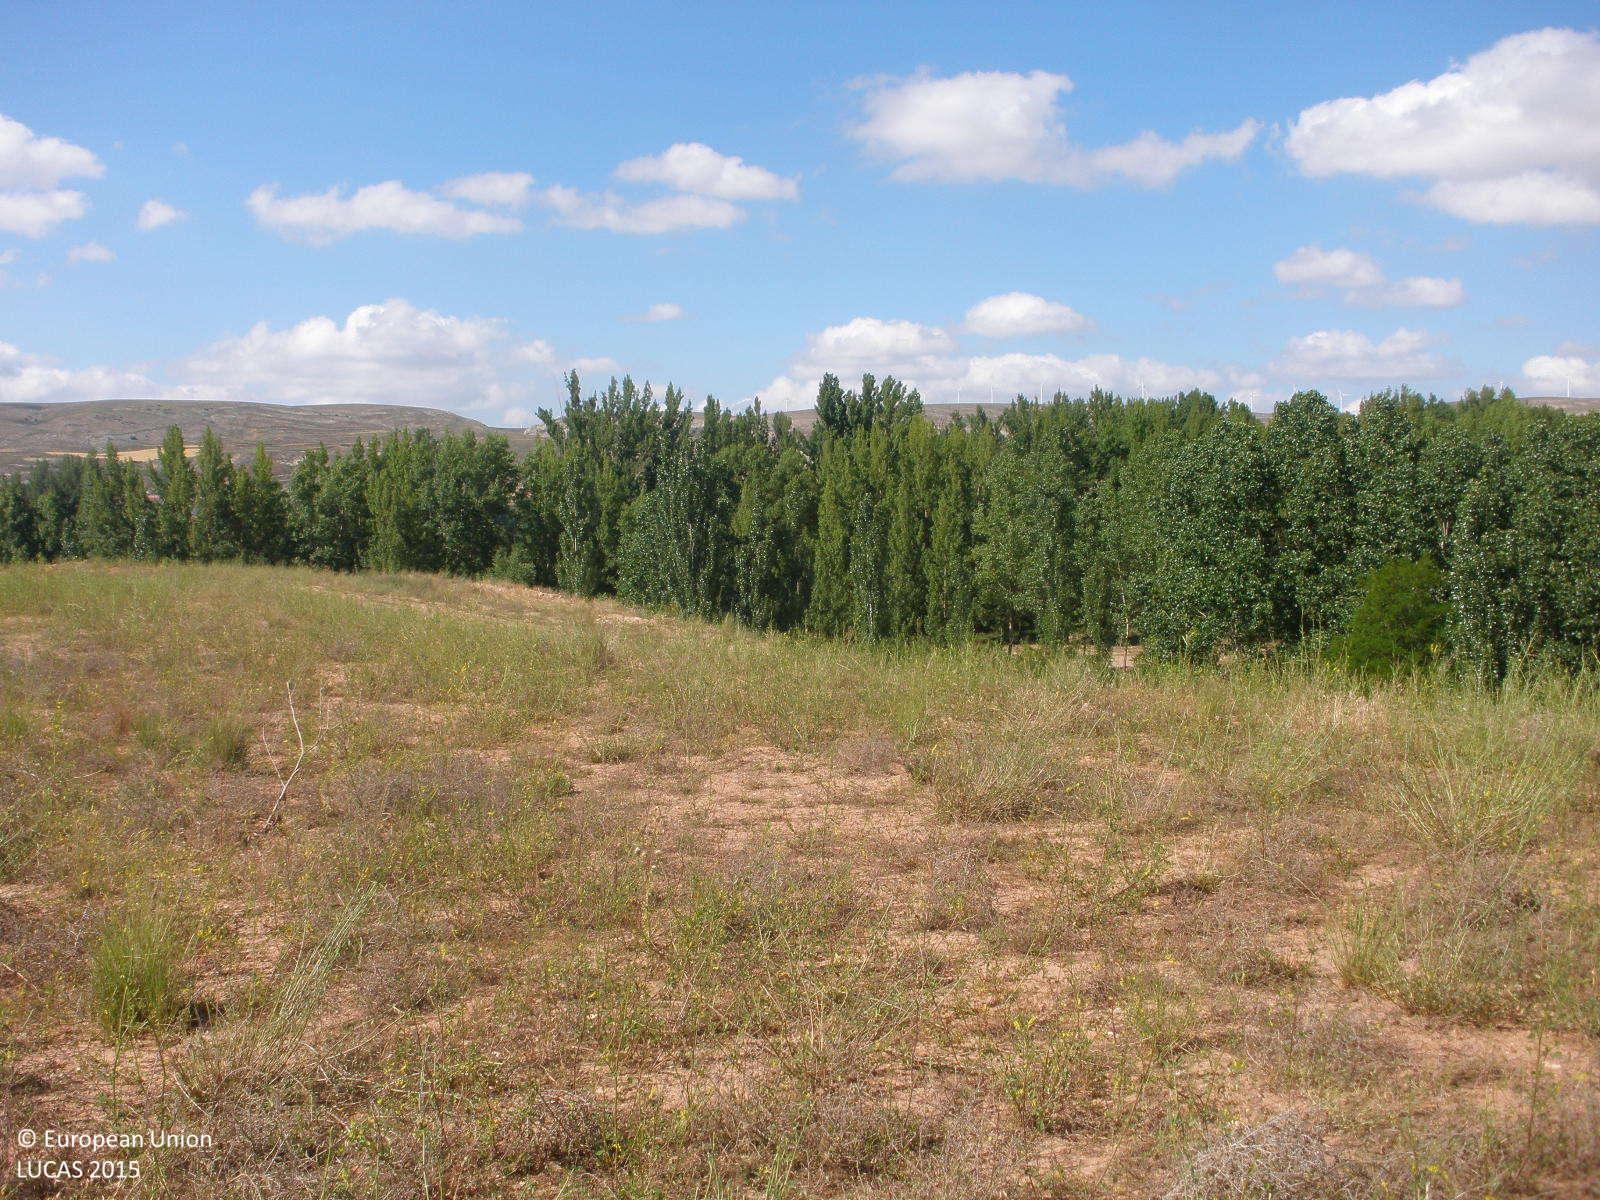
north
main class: Grassland
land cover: Spontaneously vegetated surfaces
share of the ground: > 75 %
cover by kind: herbaceous plants 80 %, unconsolidated bare surface 20 %
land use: Mining and quarrying
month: June
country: ES
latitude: 40.6452
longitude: -0.8796
